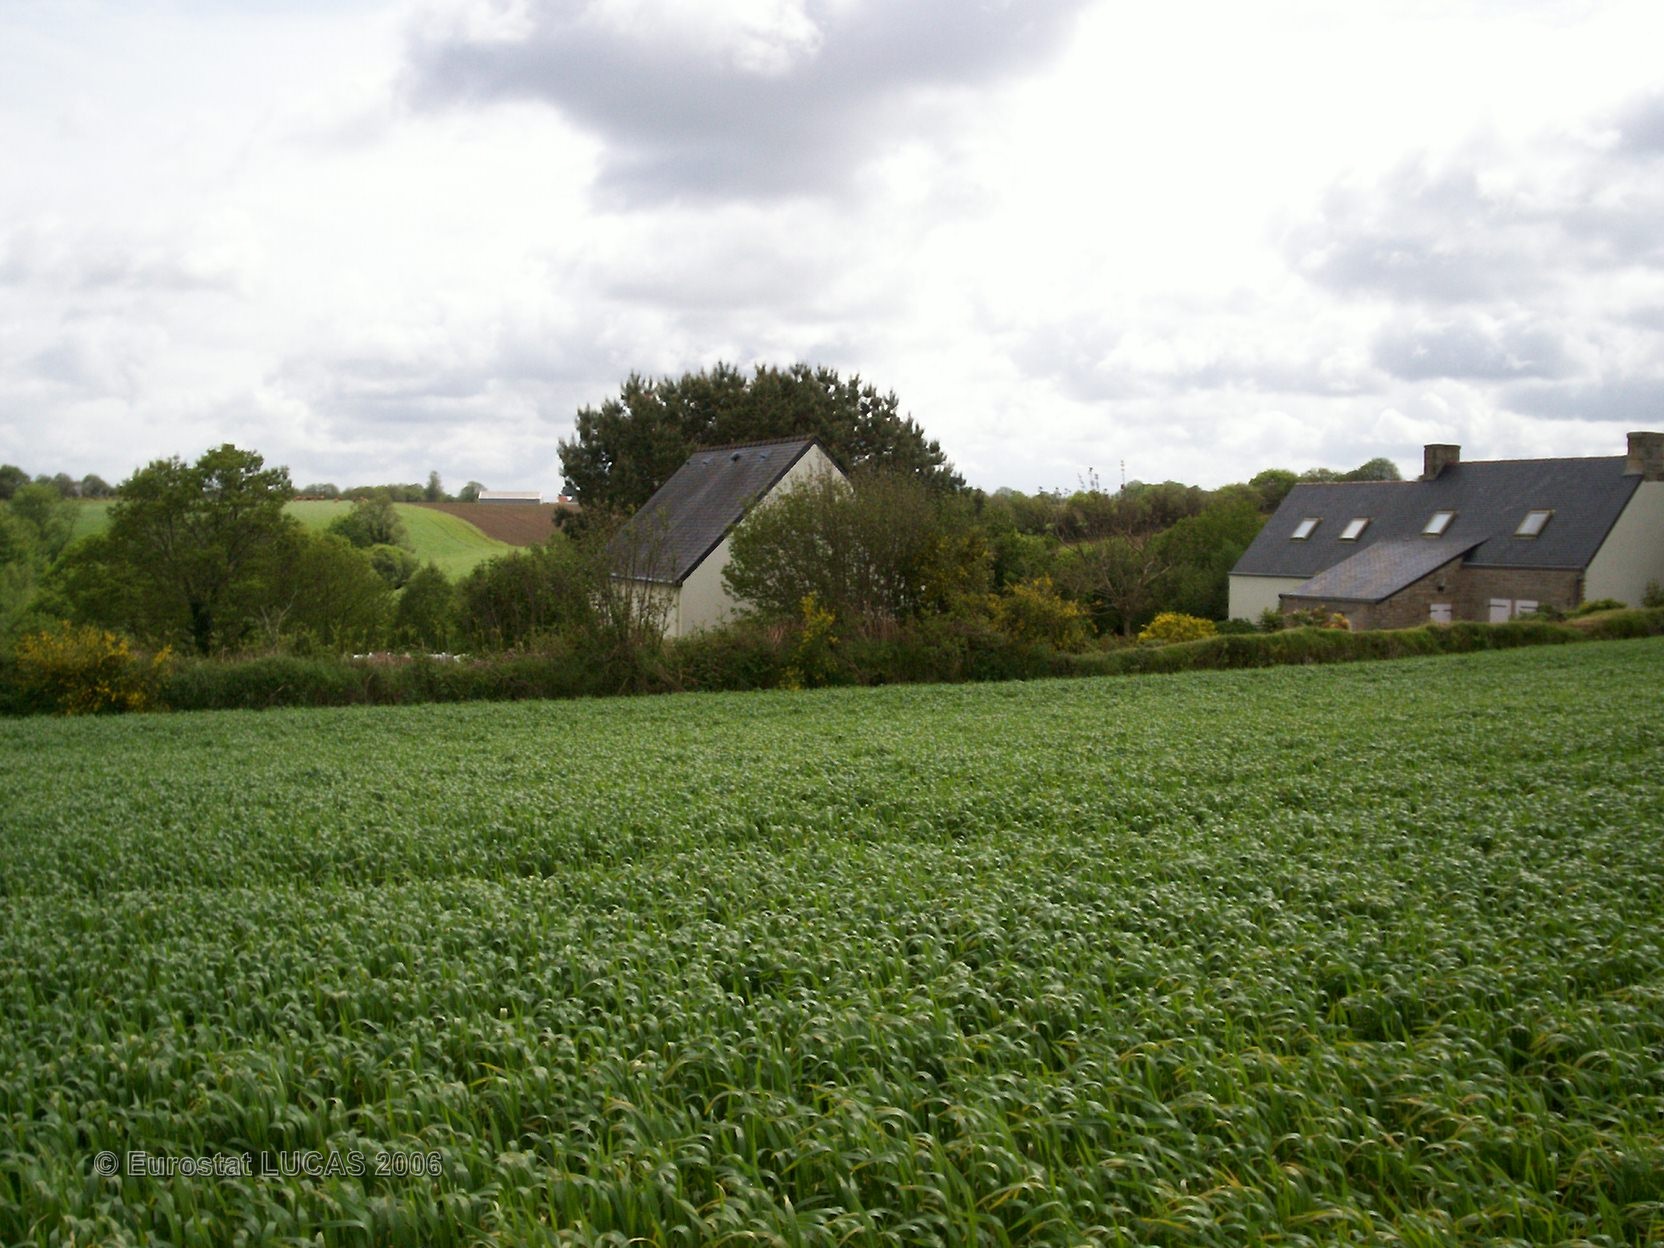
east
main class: Cropland
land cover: Triticale
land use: Agriculture (excluding fallow land and kitchen gardens)
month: May
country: FR
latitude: 48.0476
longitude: -3.9156
